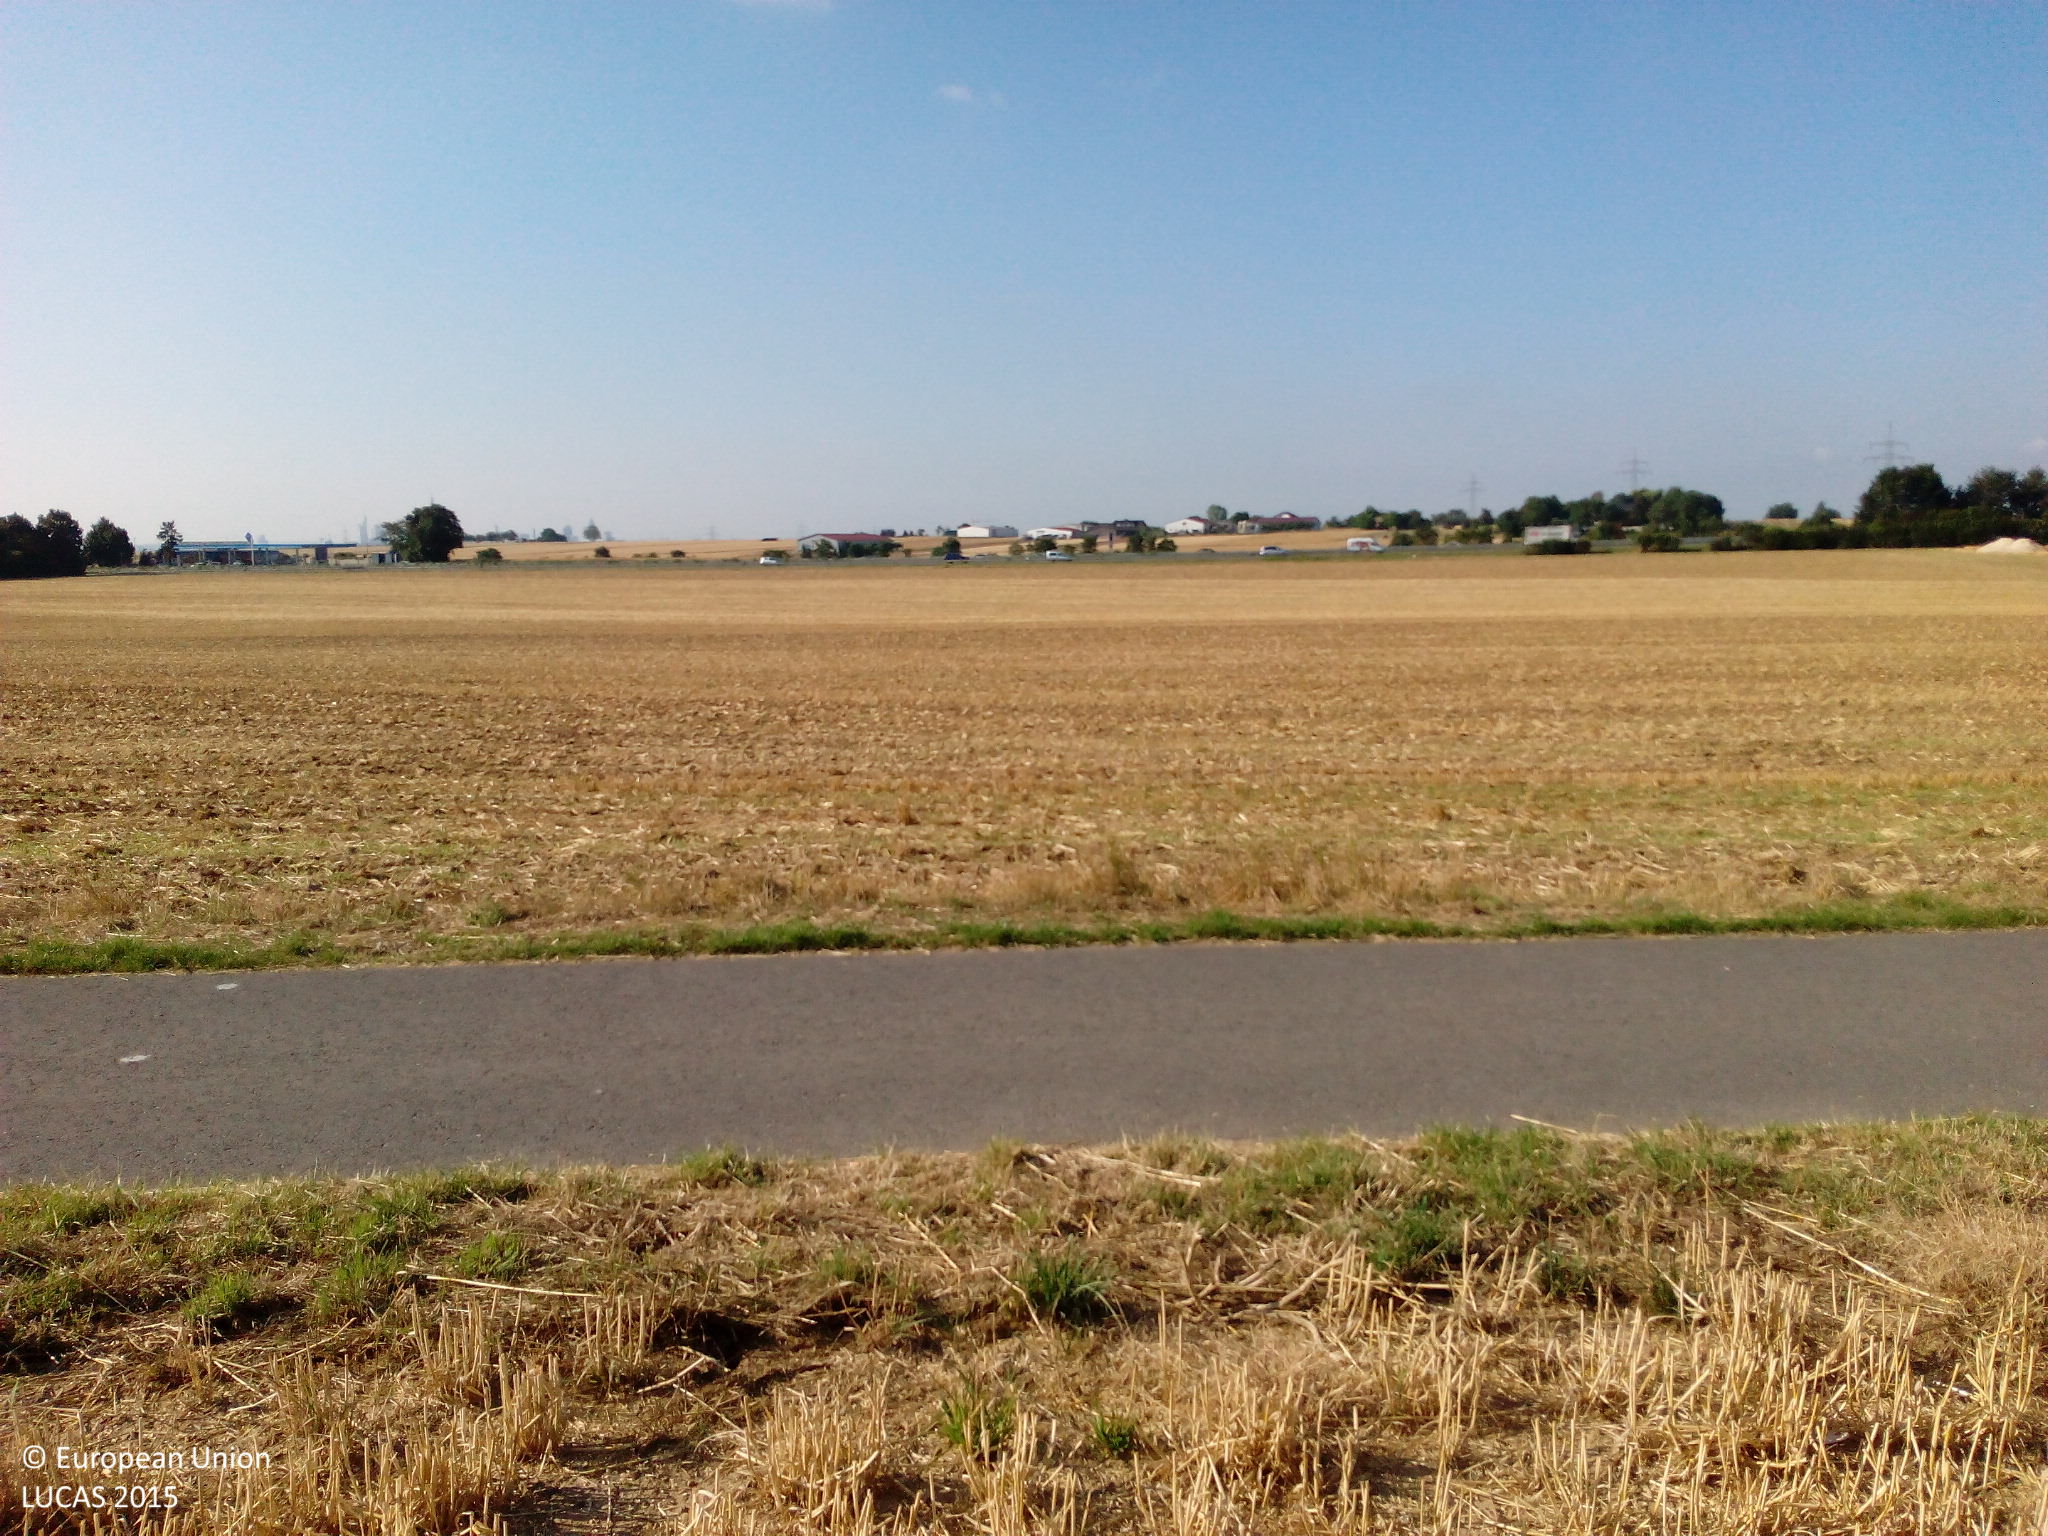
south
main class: Cropland
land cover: Common wheat
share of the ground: 50 - 75 %
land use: Agriculture (excluding fallow land and kitchen gardens)
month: July
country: DE
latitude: 50.2118
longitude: 8.6131
